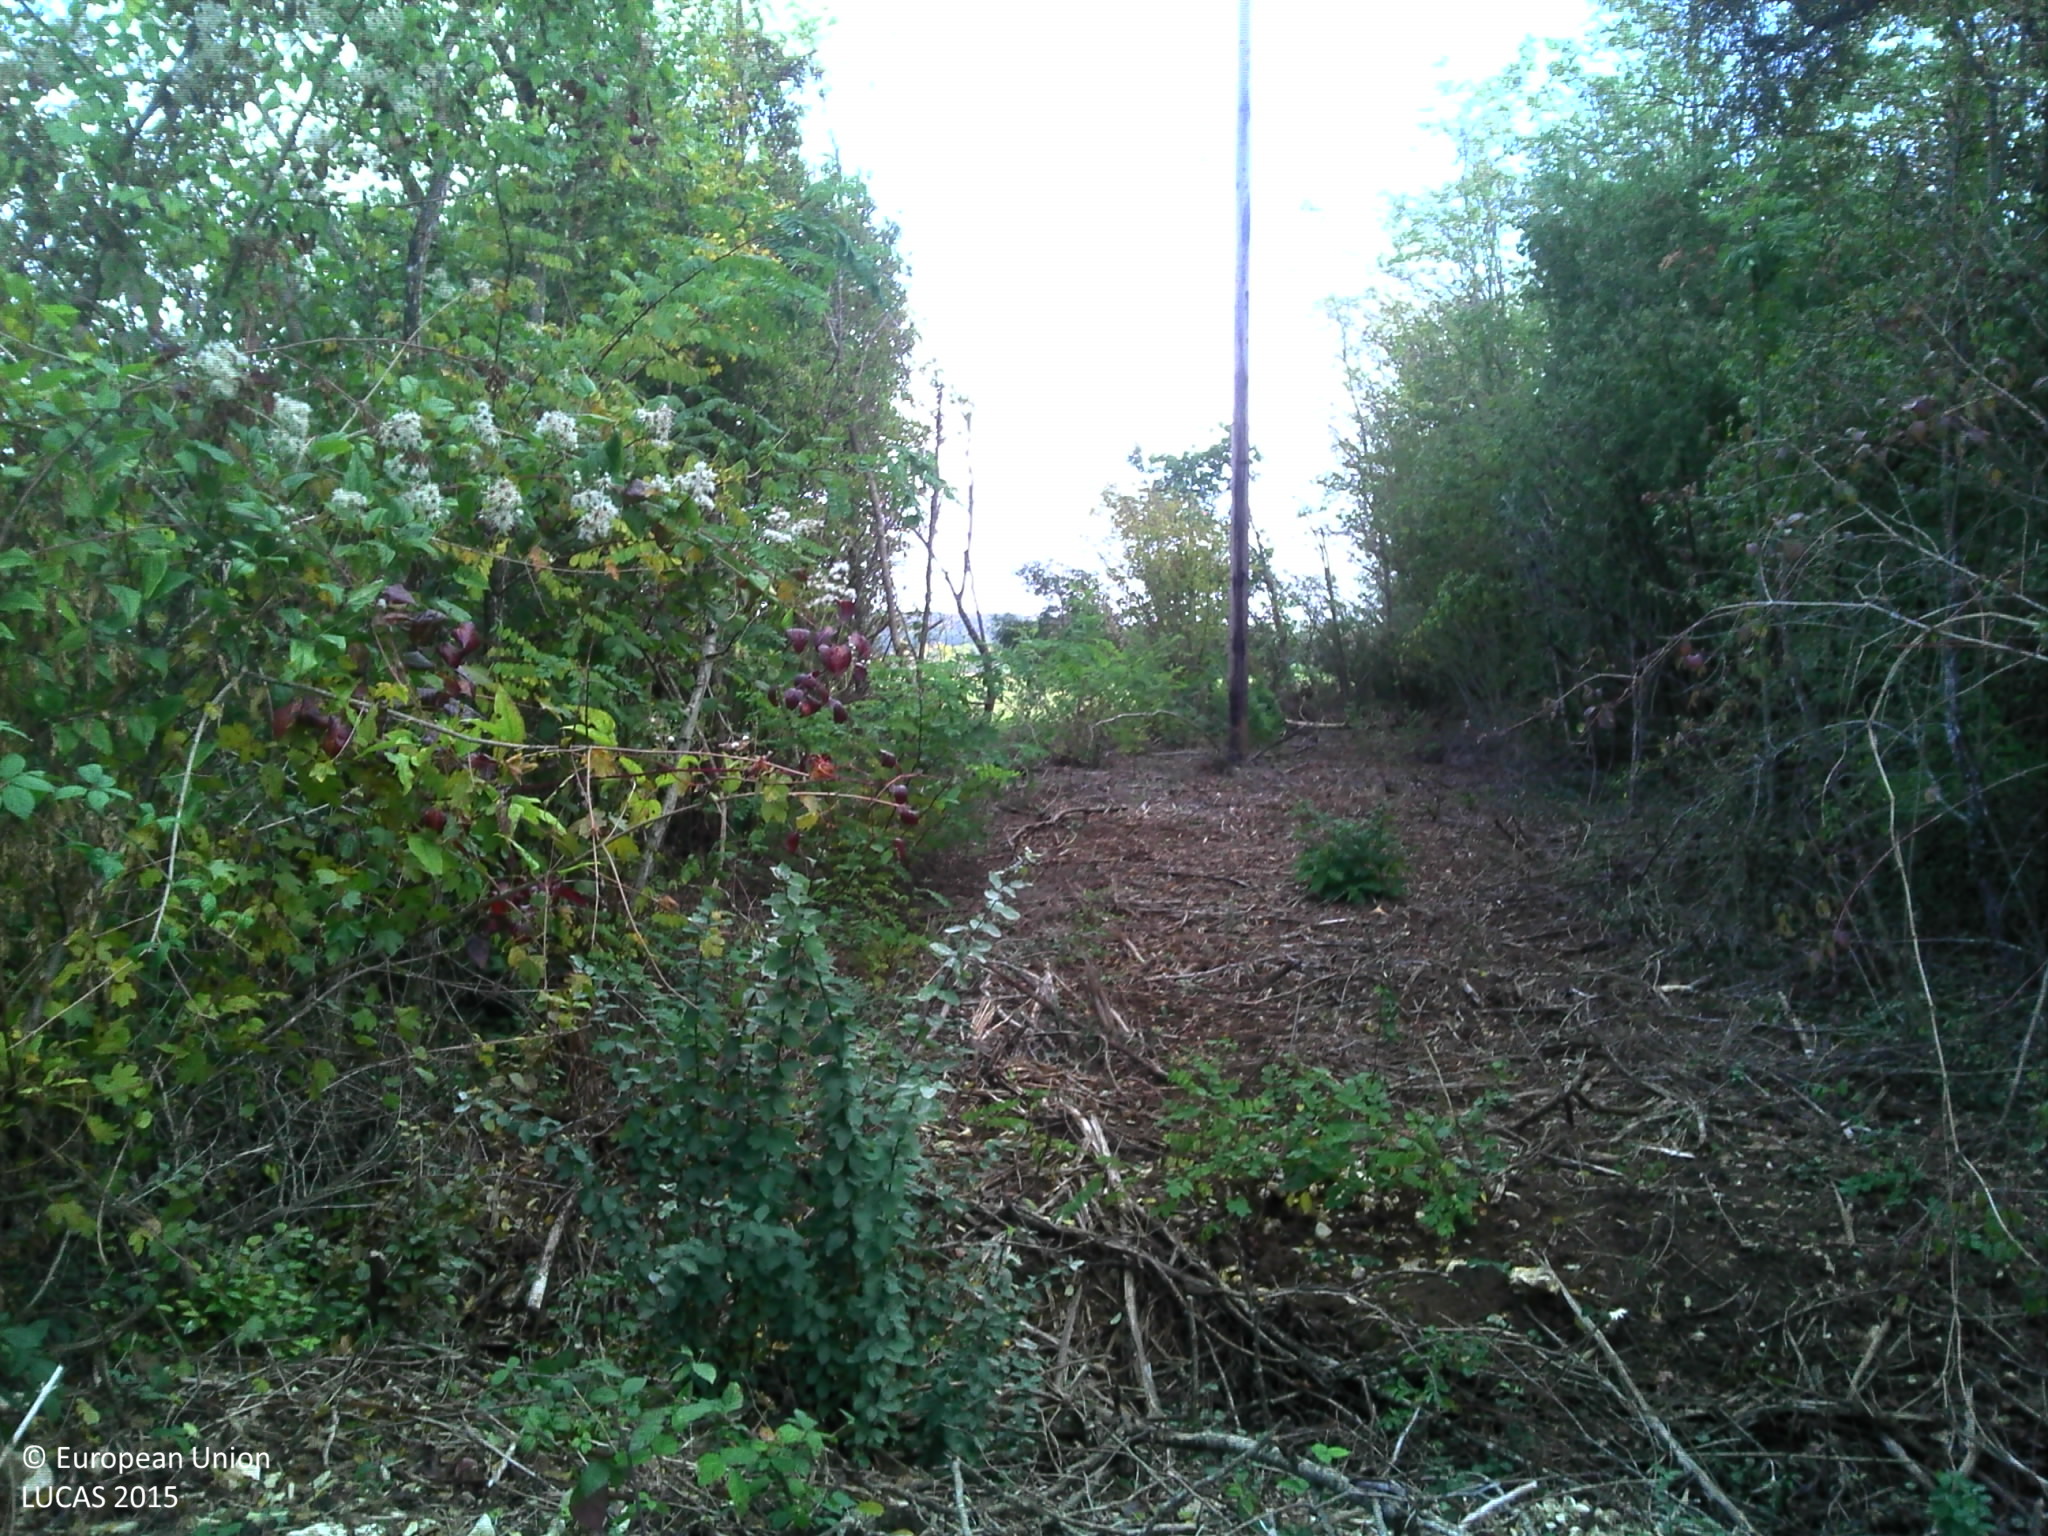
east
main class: Woodland
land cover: Broadleaved woodland
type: mesophytic deciduous forest
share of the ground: > 75 %
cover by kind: broadleaved forest trees 100 %
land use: Forestry
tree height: > 5 m
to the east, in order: Broadleaved woodland; Temporary grasslands; Grass margins; Paved roads, cycling and walking lanes; Grass margins; Temporary grasslands
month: October
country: FR
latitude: 47.5626
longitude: 5.2555
